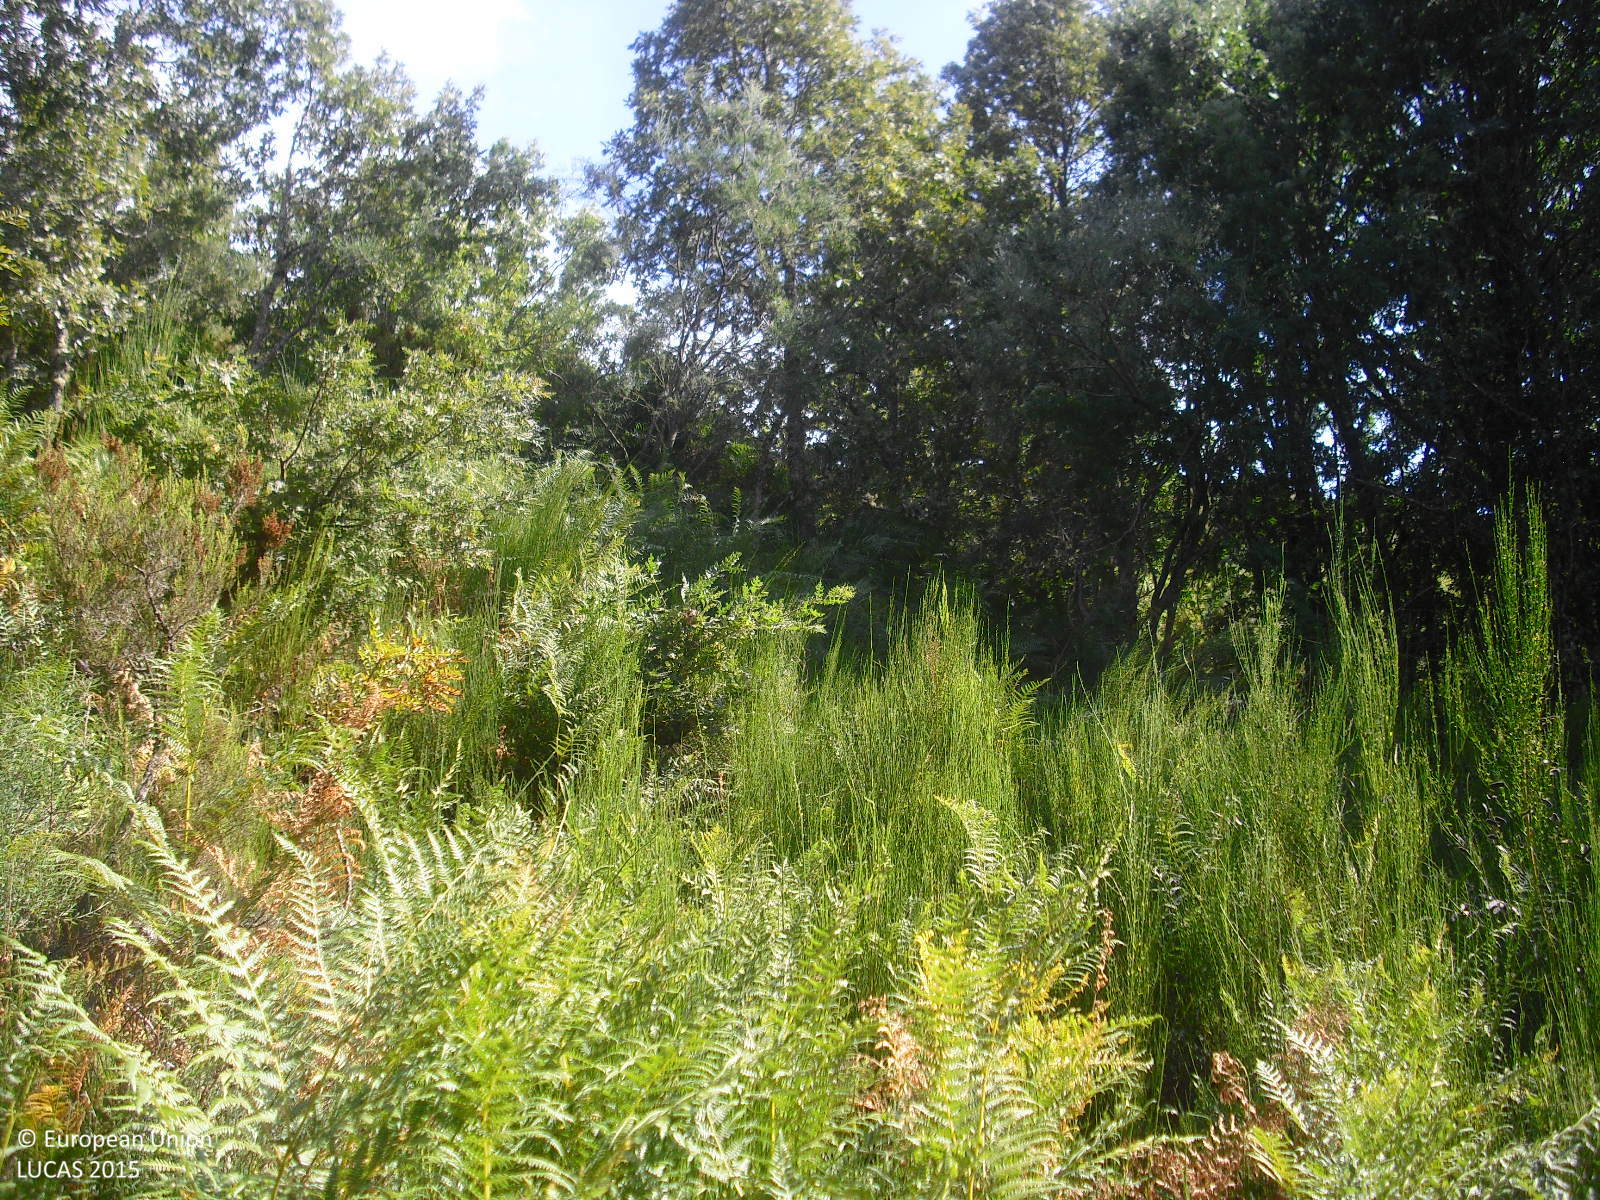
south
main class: Woodland
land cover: Broadleaved woodland
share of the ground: 50 - 75 %
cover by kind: broadleaved forest trees 70 %, shrubs 30 %
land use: Semi-natural and natural areas not in use
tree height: > 5 m
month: August
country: ES
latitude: 42.1126
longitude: -7.3920
